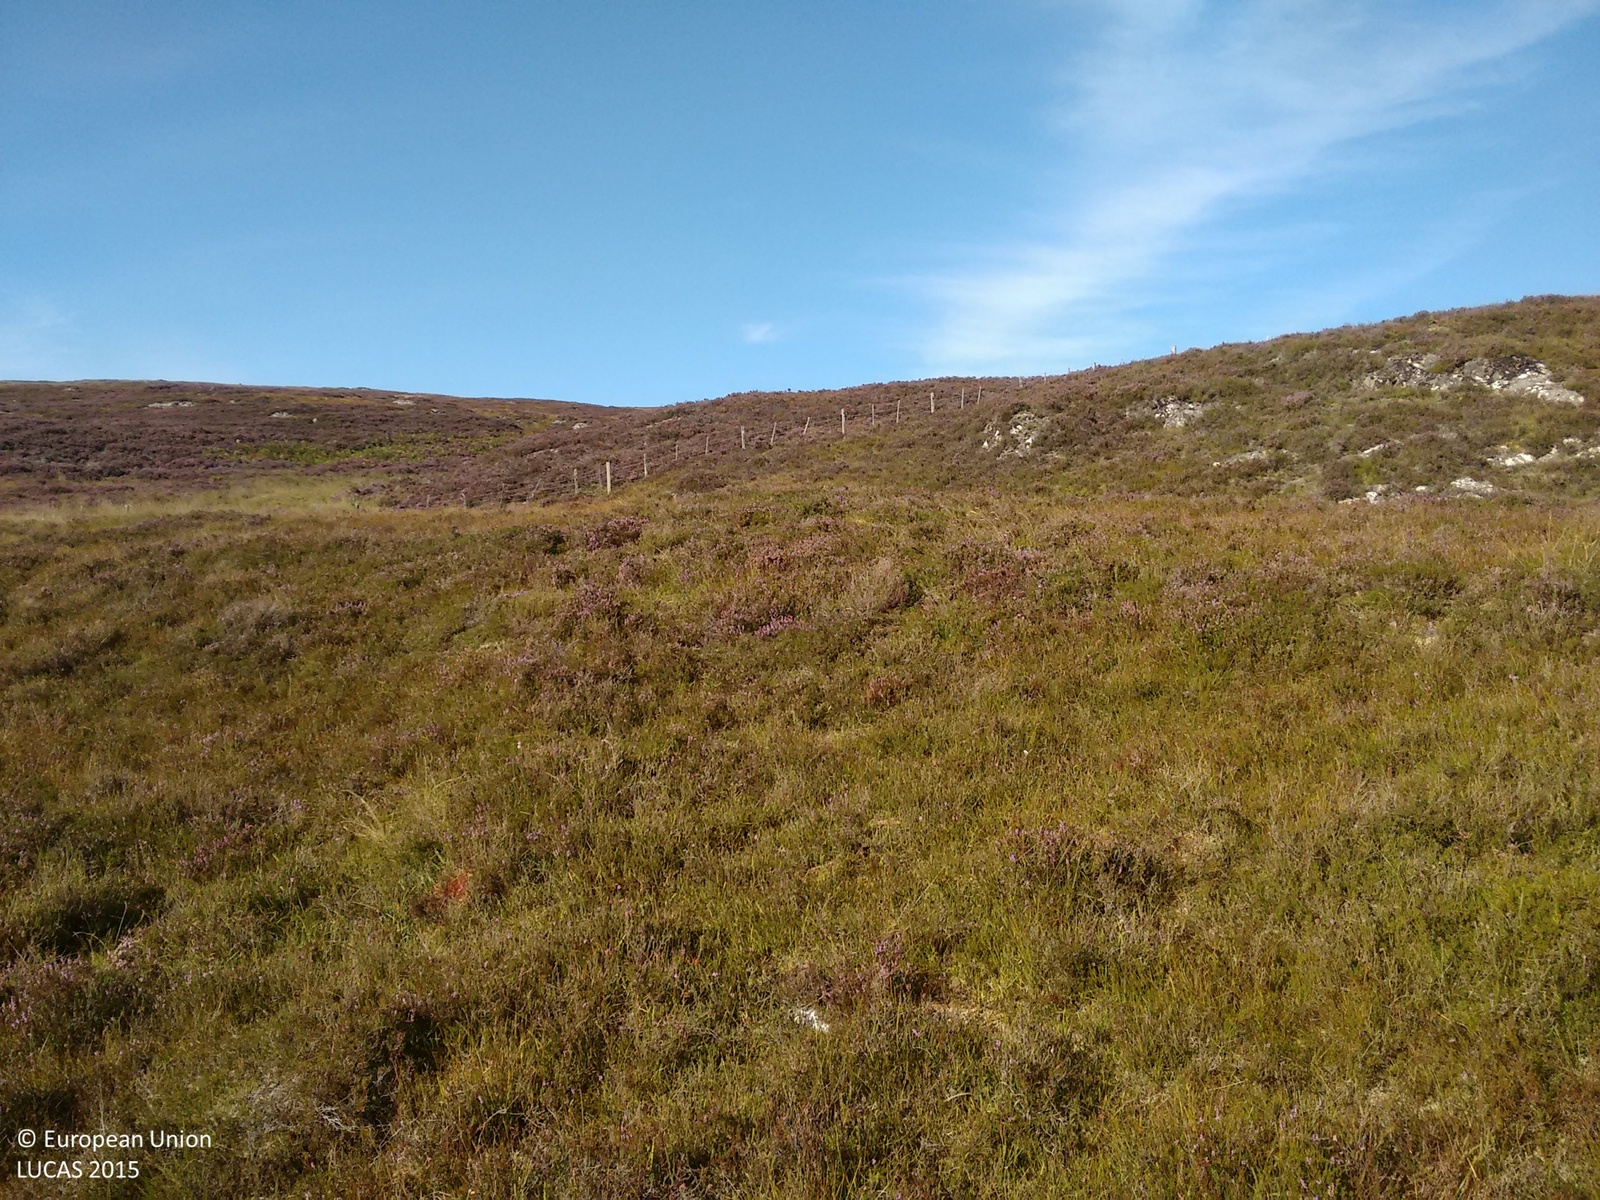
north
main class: Shrubland
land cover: Shrubland without tree cover
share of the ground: > 75 %
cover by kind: shrubs 100 %
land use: Agriculture (excluding fallow land and kitchen gardens)
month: September
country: GB
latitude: 57.9199
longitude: -4.3503
